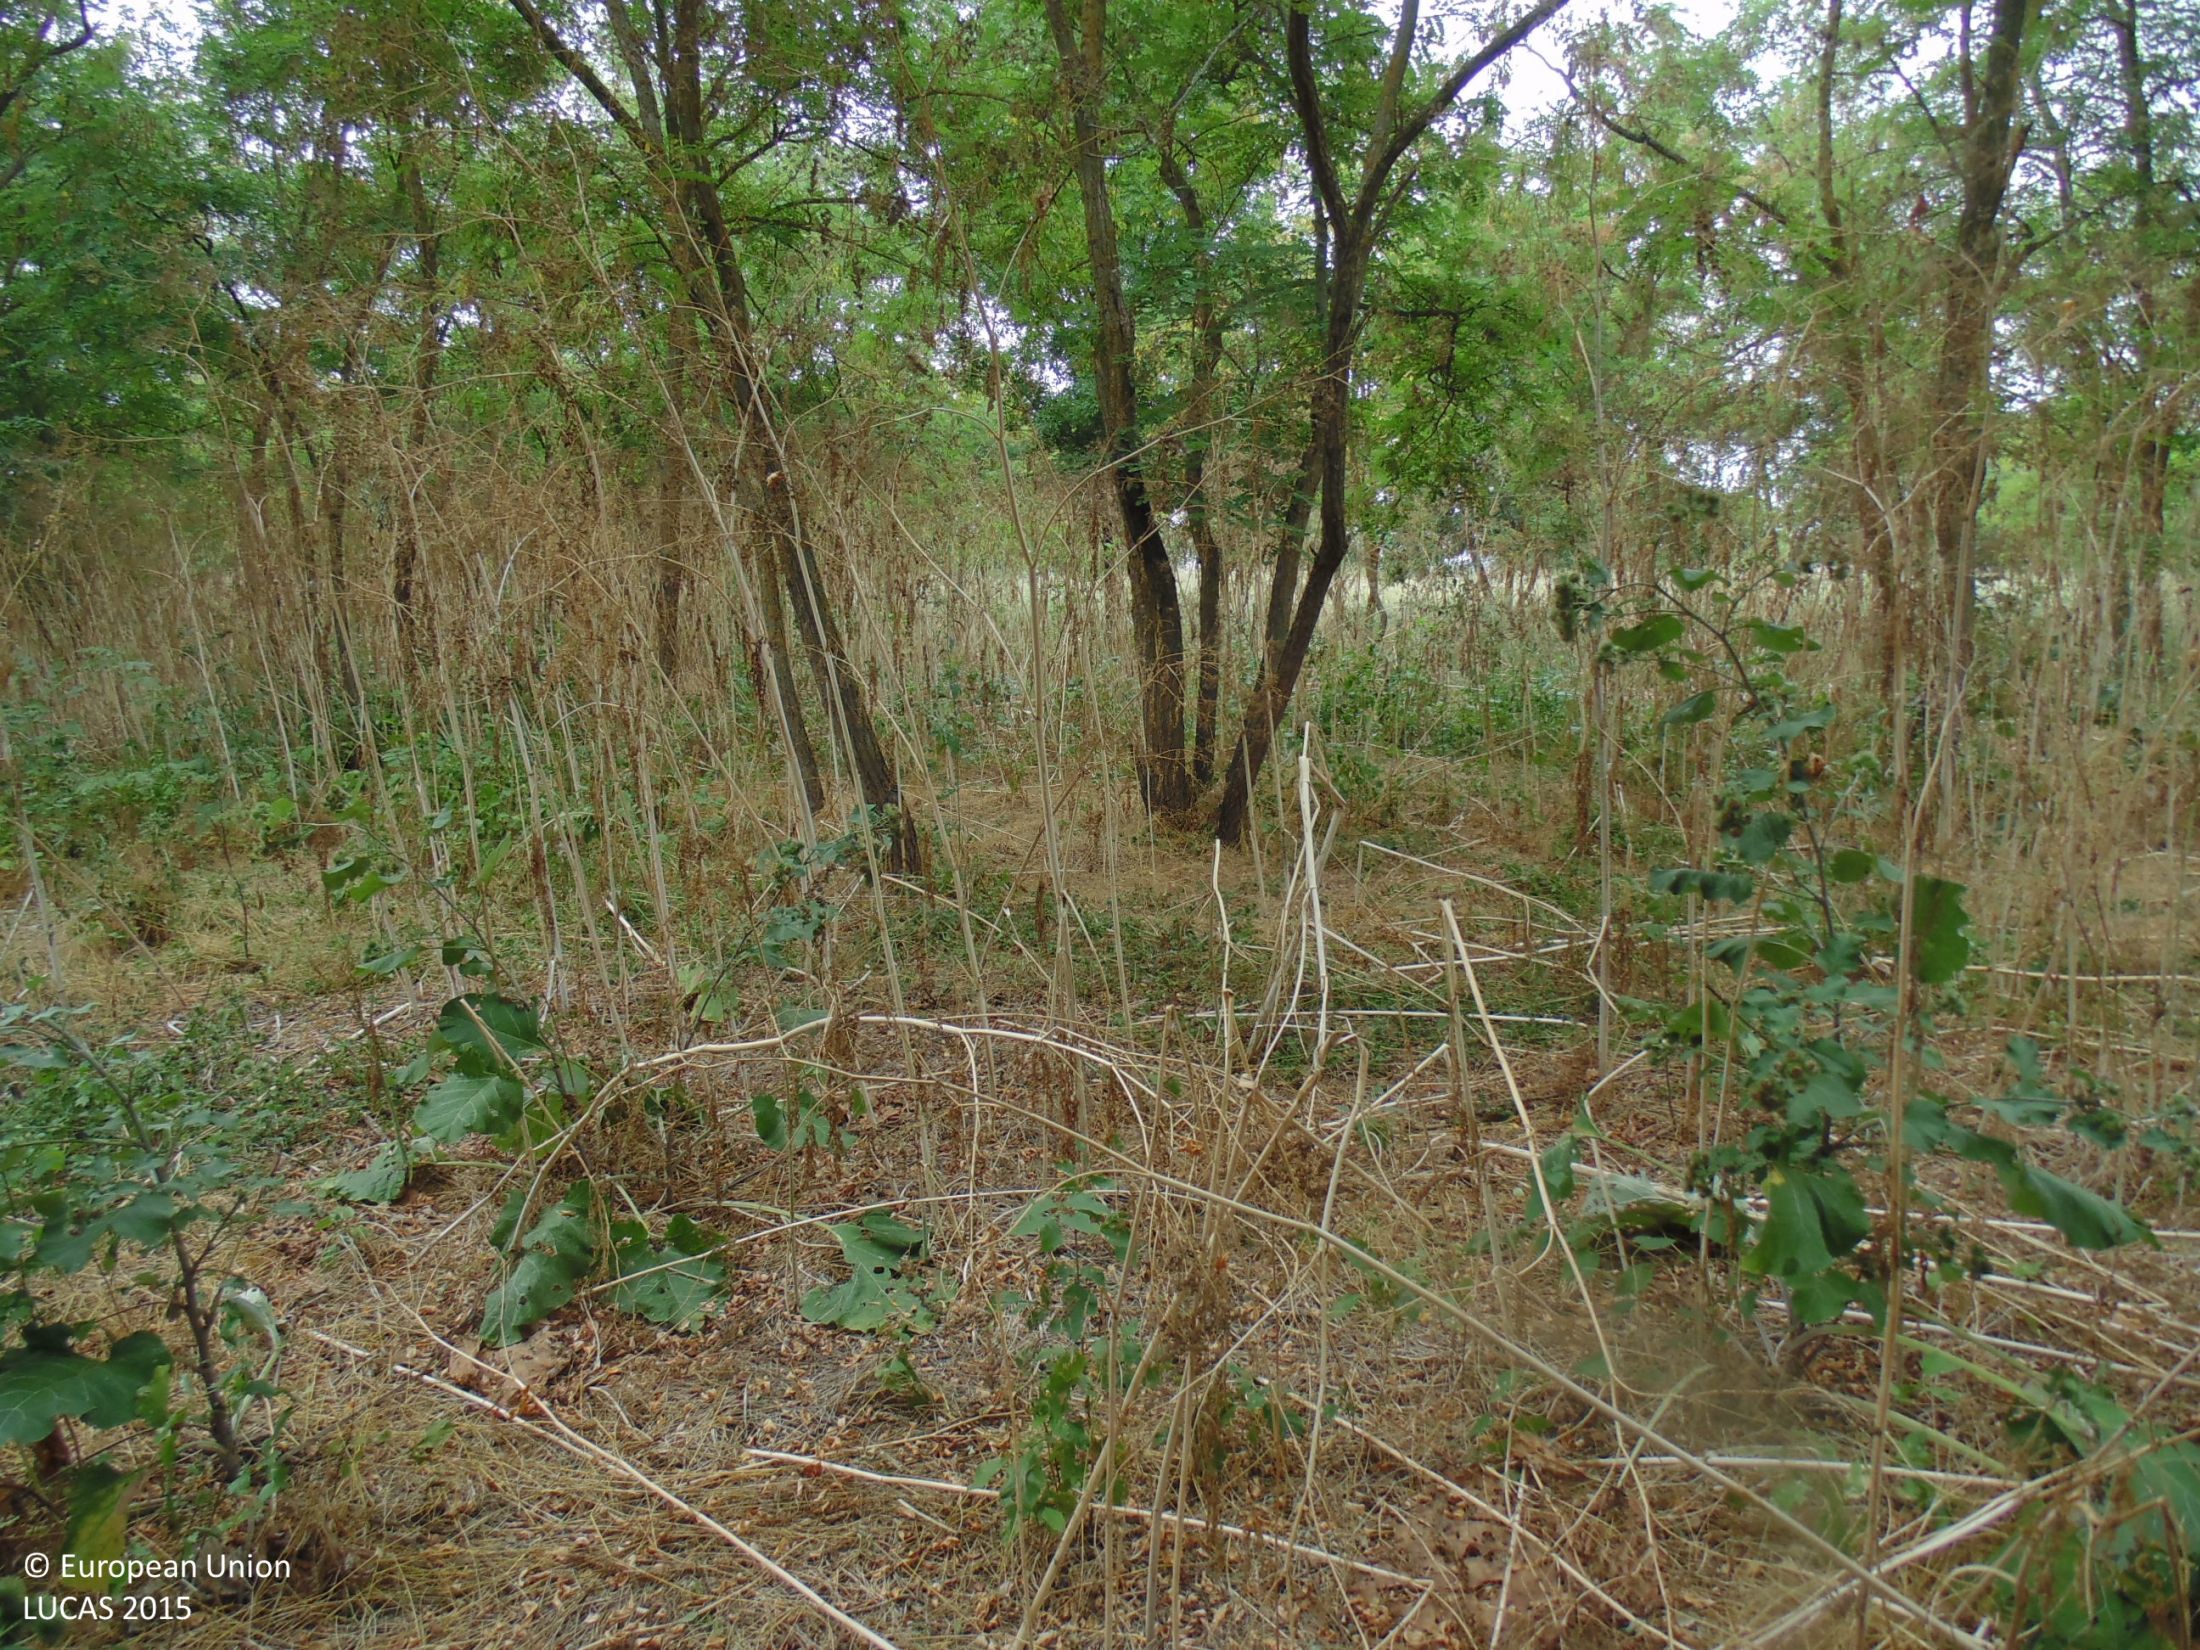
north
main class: Woodland
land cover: Broadleaved woodland
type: mesophytic deciduous forest
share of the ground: > 75 %
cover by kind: broadleaved forest trees 90 %, shrubs 10 %
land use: Forestry
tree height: > 5 m
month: August
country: BG
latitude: 43.5695
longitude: 28.5248
